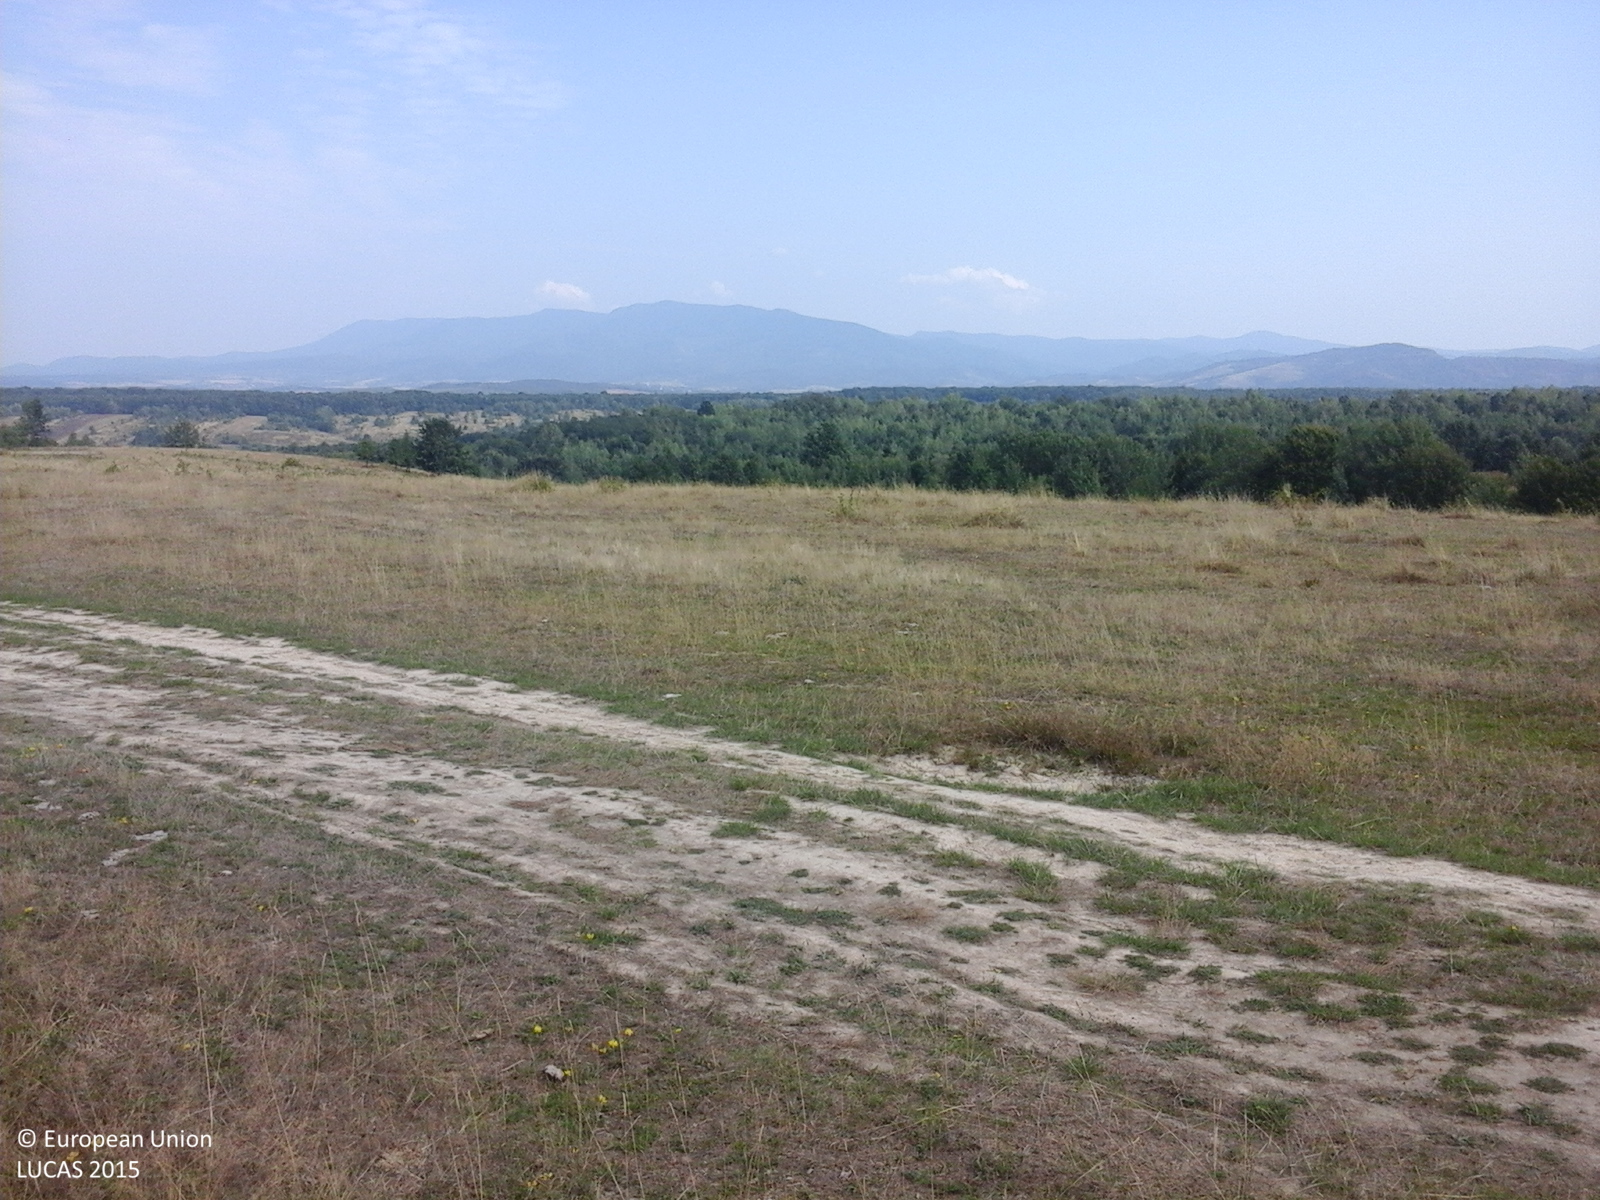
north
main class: Grassland
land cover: Grassland with sparse tree/shrub cover
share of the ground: > 75 %
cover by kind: herbaceous plants 85 %, shrubs 10 %, broadleaved forest trees 5 %
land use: Agriculture (excluding fallow land and kitchen gardens)
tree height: < 5 m
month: August
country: RO
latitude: 46.3601
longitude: 22.1985
